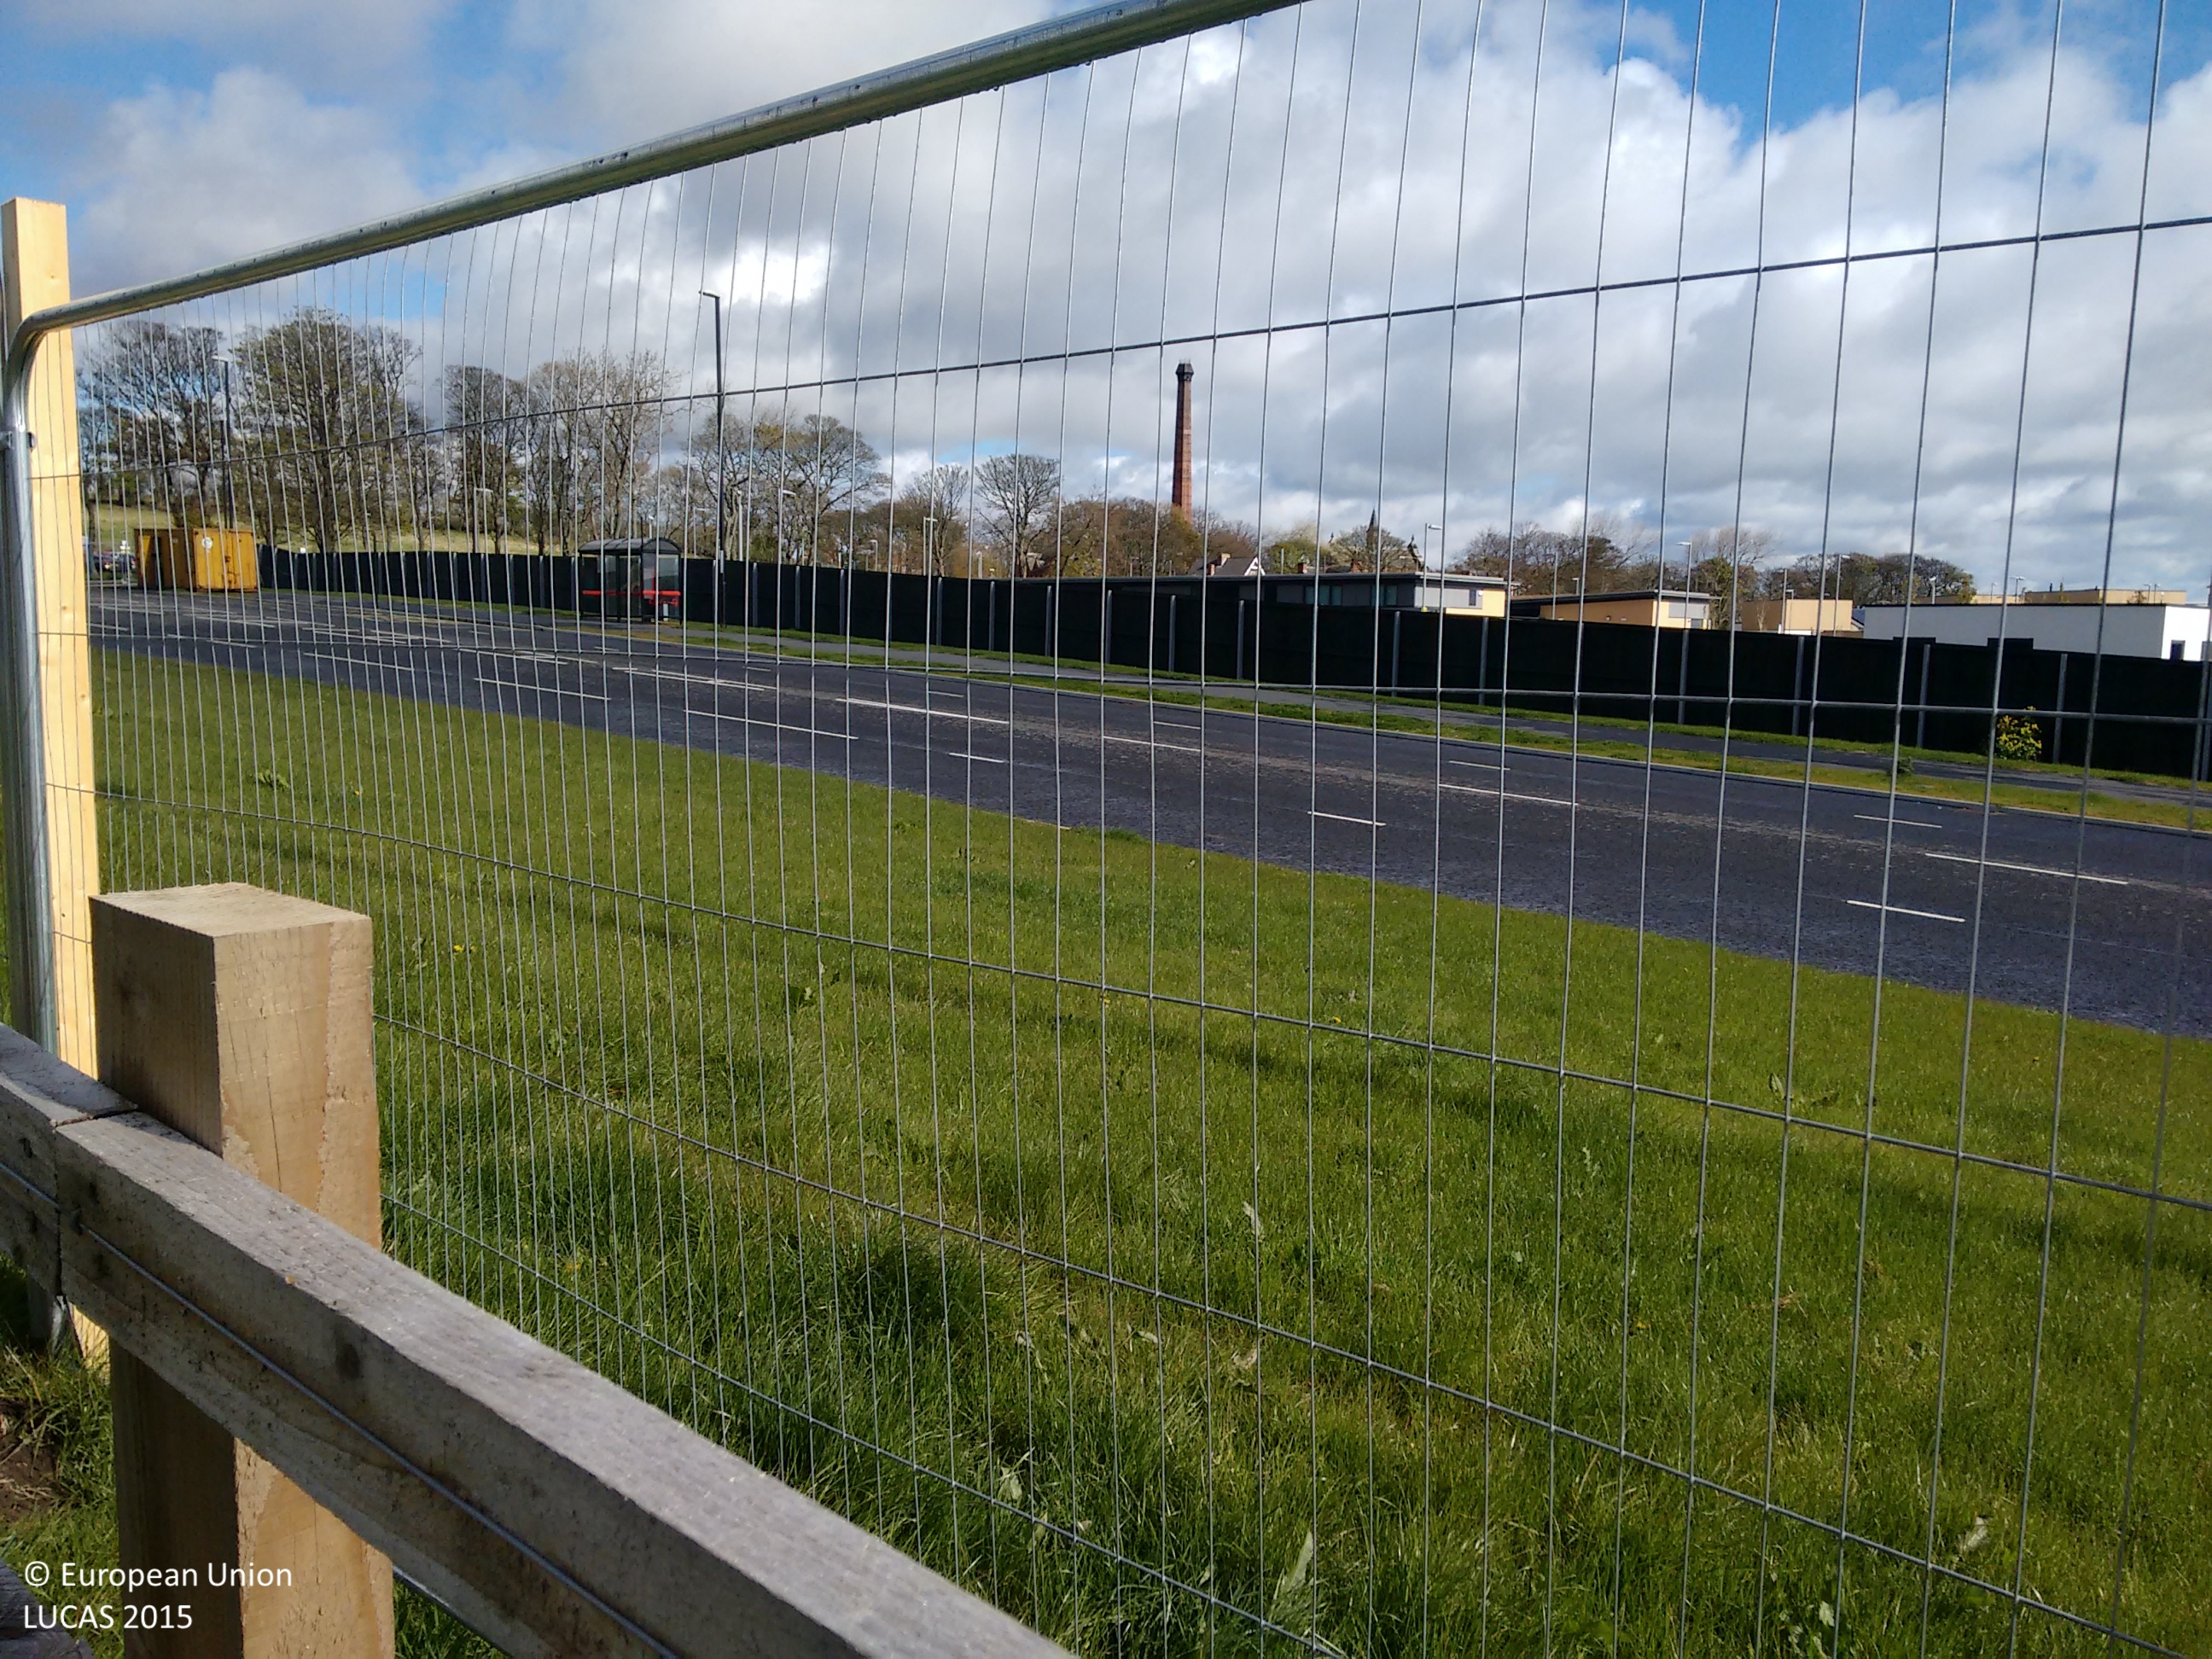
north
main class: Grassland
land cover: Grassland without tree/shrub cover
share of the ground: > 75 %
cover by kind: herbaceous plants 100 %
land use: Community services
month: April
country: GB
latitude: 54.8626
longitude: -1.3723
